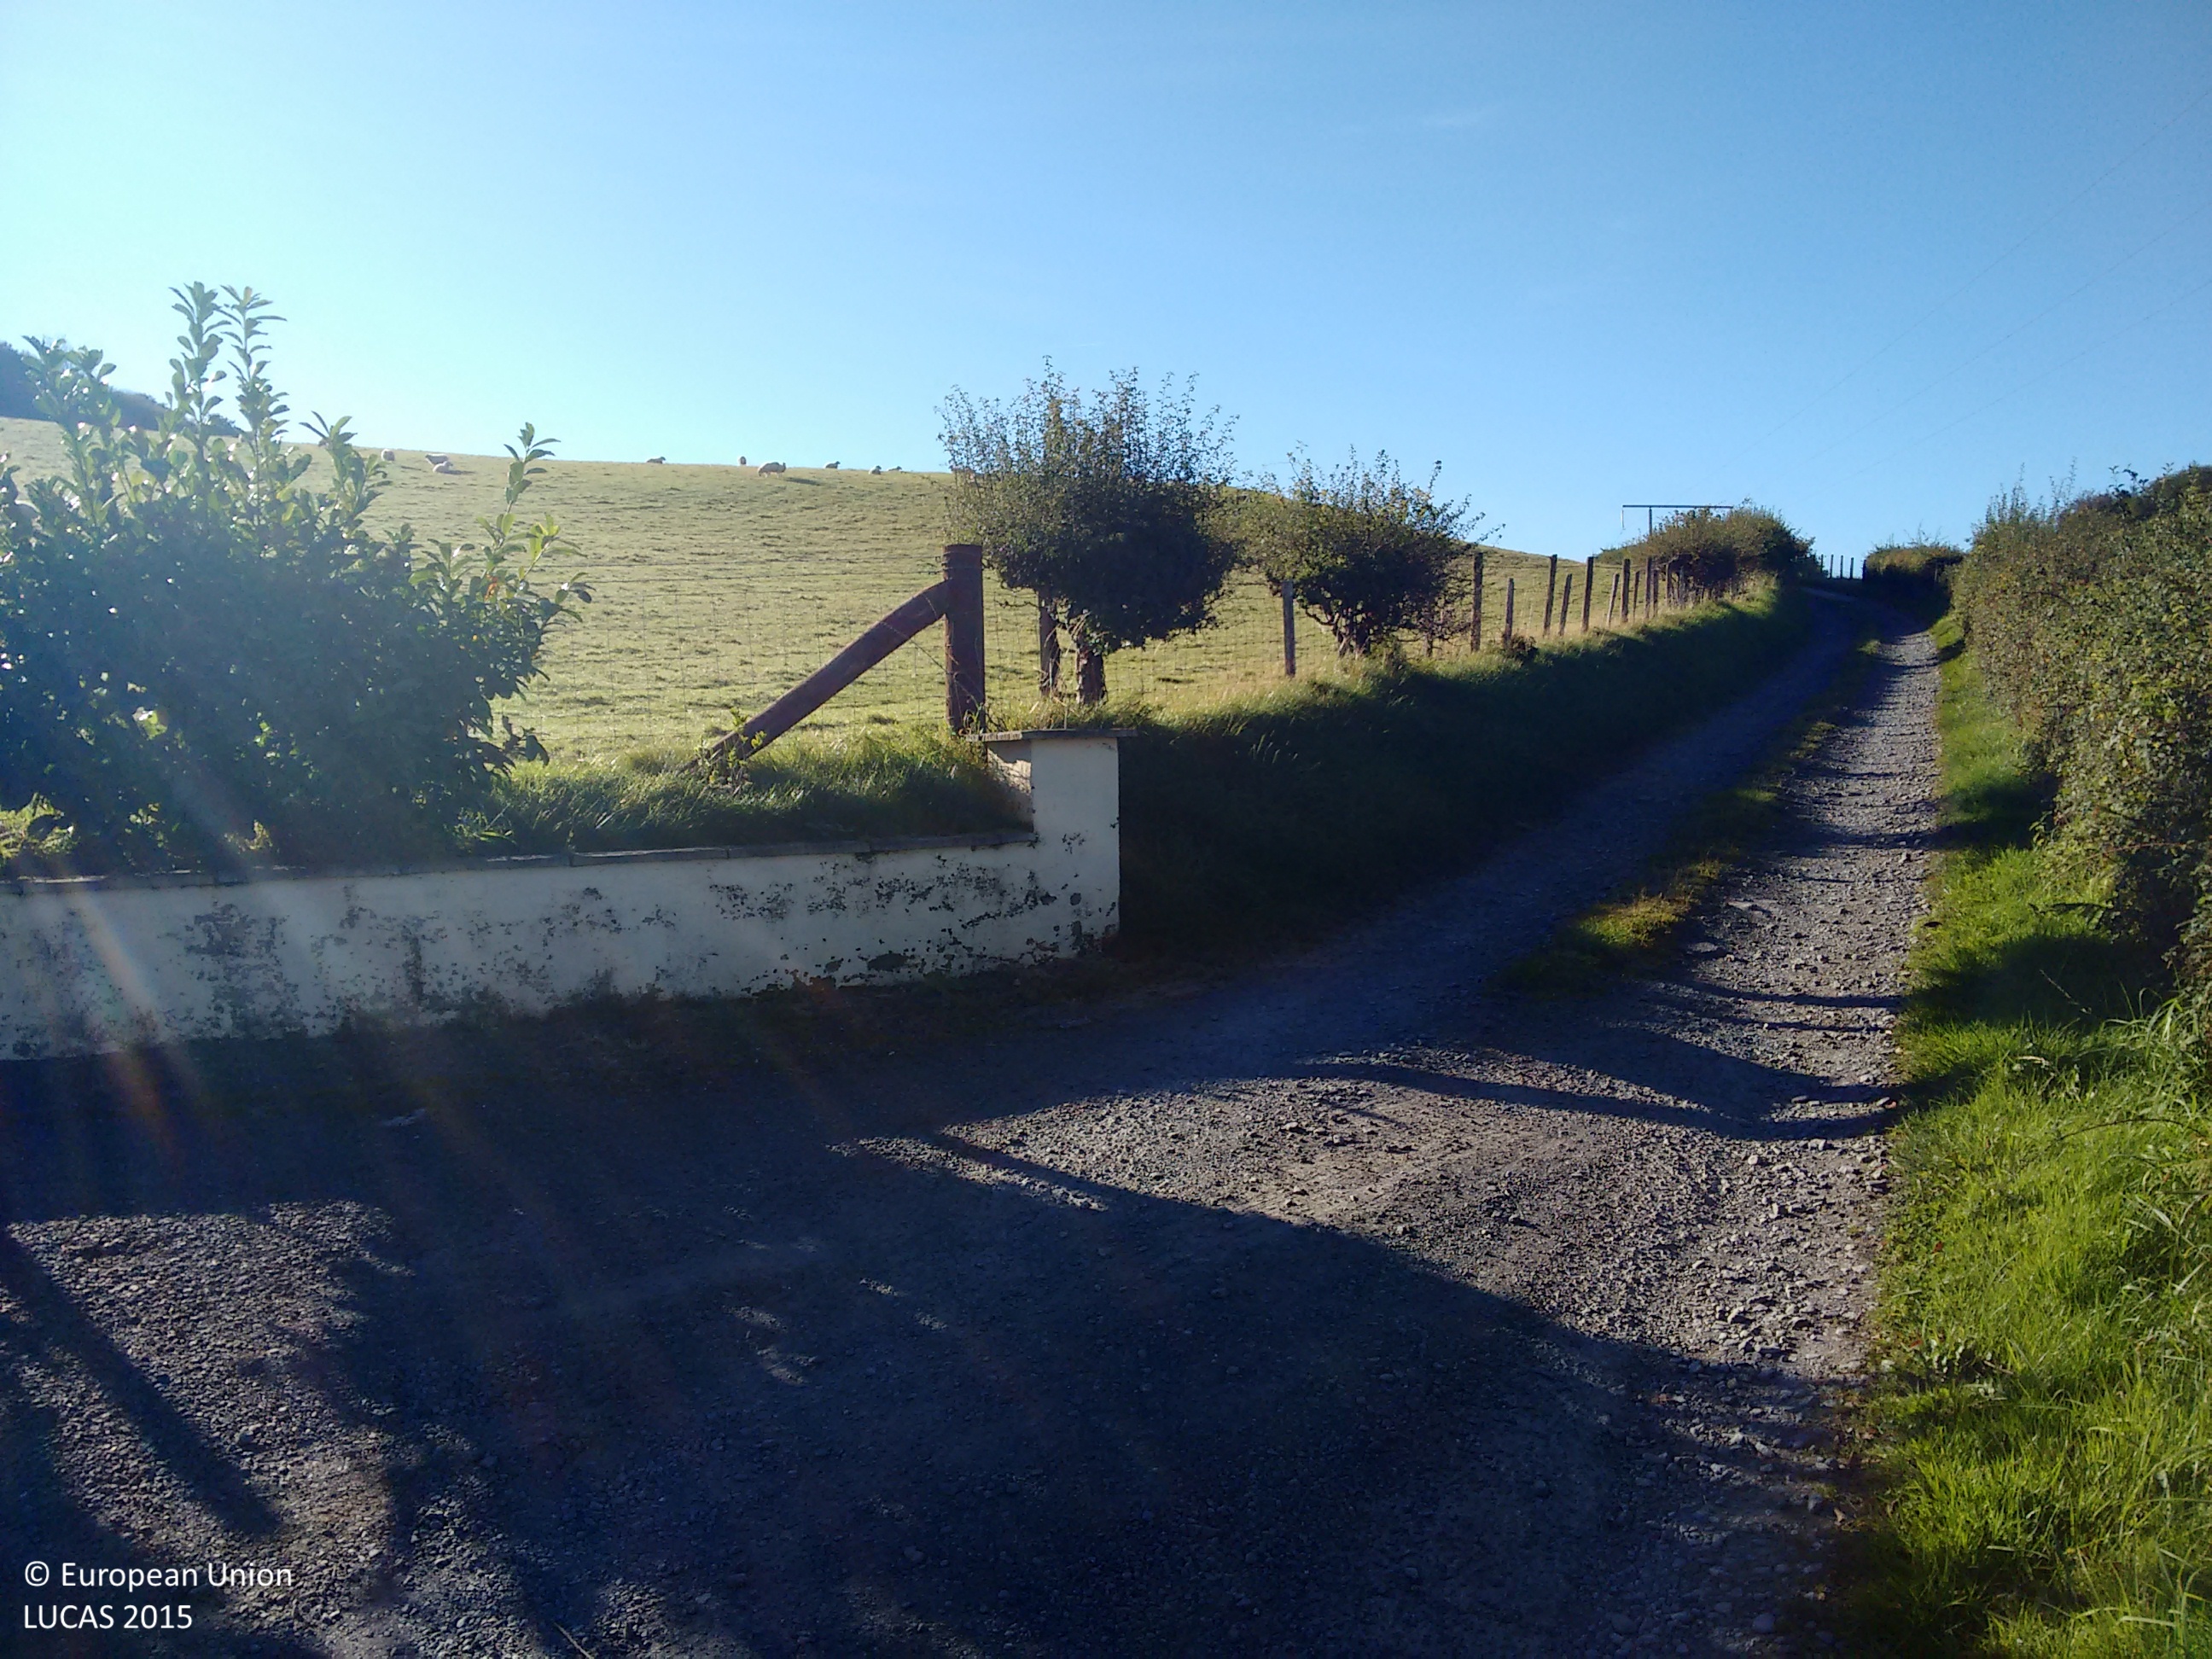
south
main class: Grassland
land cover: Grassland without tree/shrub cover
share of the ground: > 75 %
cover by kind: herbaceous plants 100 %
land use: Agriculture (excluding fallow land and kitchen gardens)
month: October
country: GB
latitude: 52.3955
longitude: -4.0419
